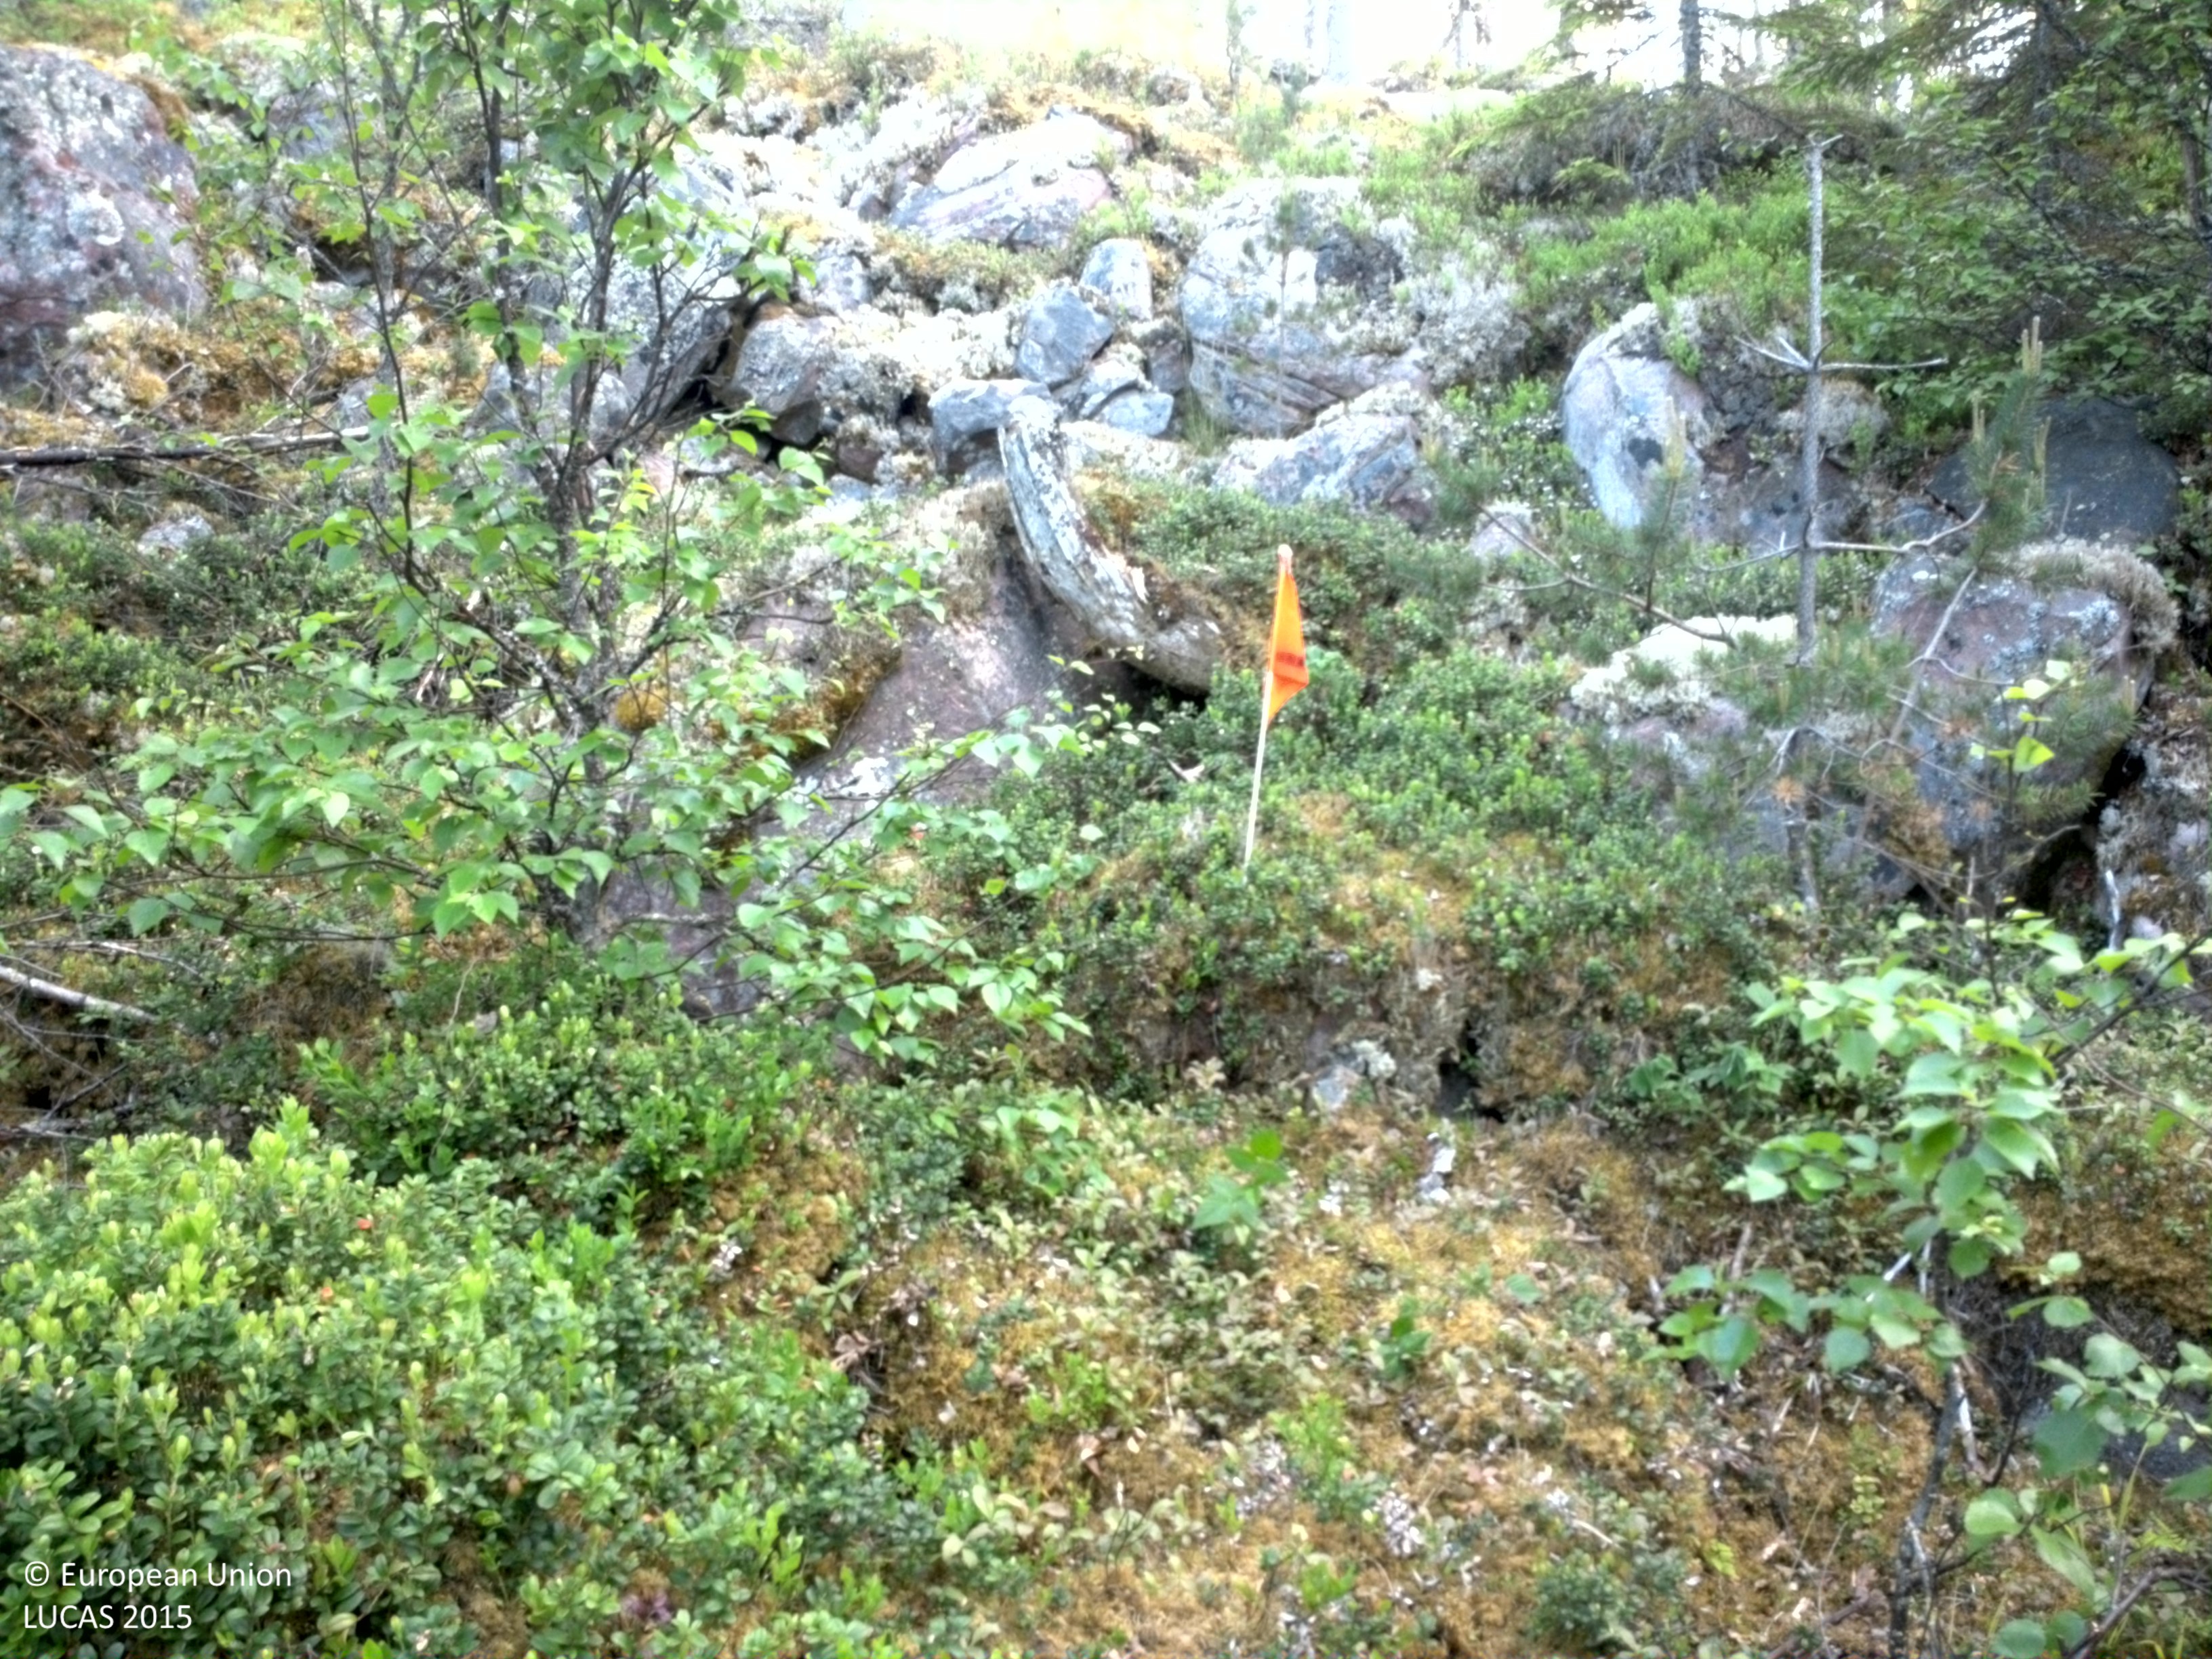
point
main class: Woodland
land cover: Other mixed woodland
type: boreal forest
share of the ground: 50 - 75 %
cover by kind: coniferous forest trees 30 %, shrubs 25 %, lichens and mosses 25 %, broadleaved forest trees 10 %, herbaceous plants 10 %
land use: Forestry
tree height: > 5 m
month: June
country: SE
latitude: 61.0891
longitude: 13.6409
